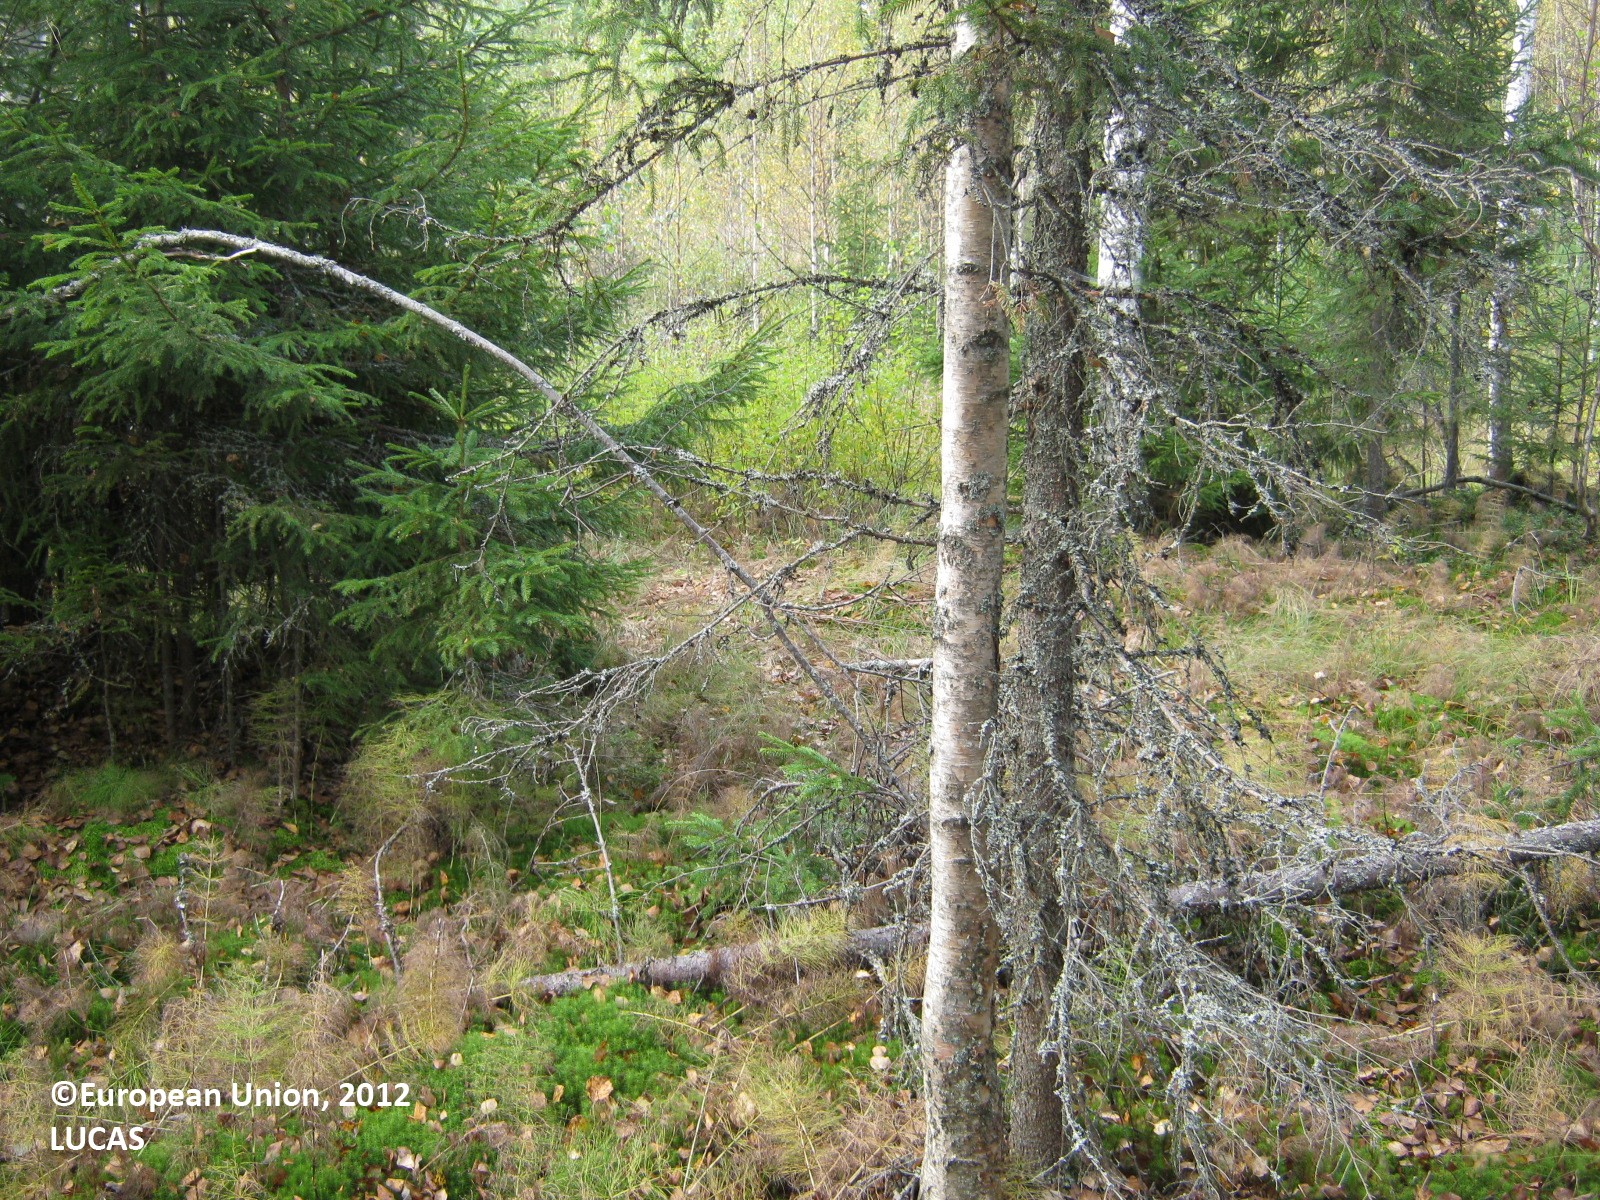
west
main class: Woodland
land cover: Spruce dominated mixed woodland
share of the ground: > 75 %
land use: Forestry
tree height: < 5 m
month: September
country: FI
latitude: 60.9126
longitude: 28.1855
